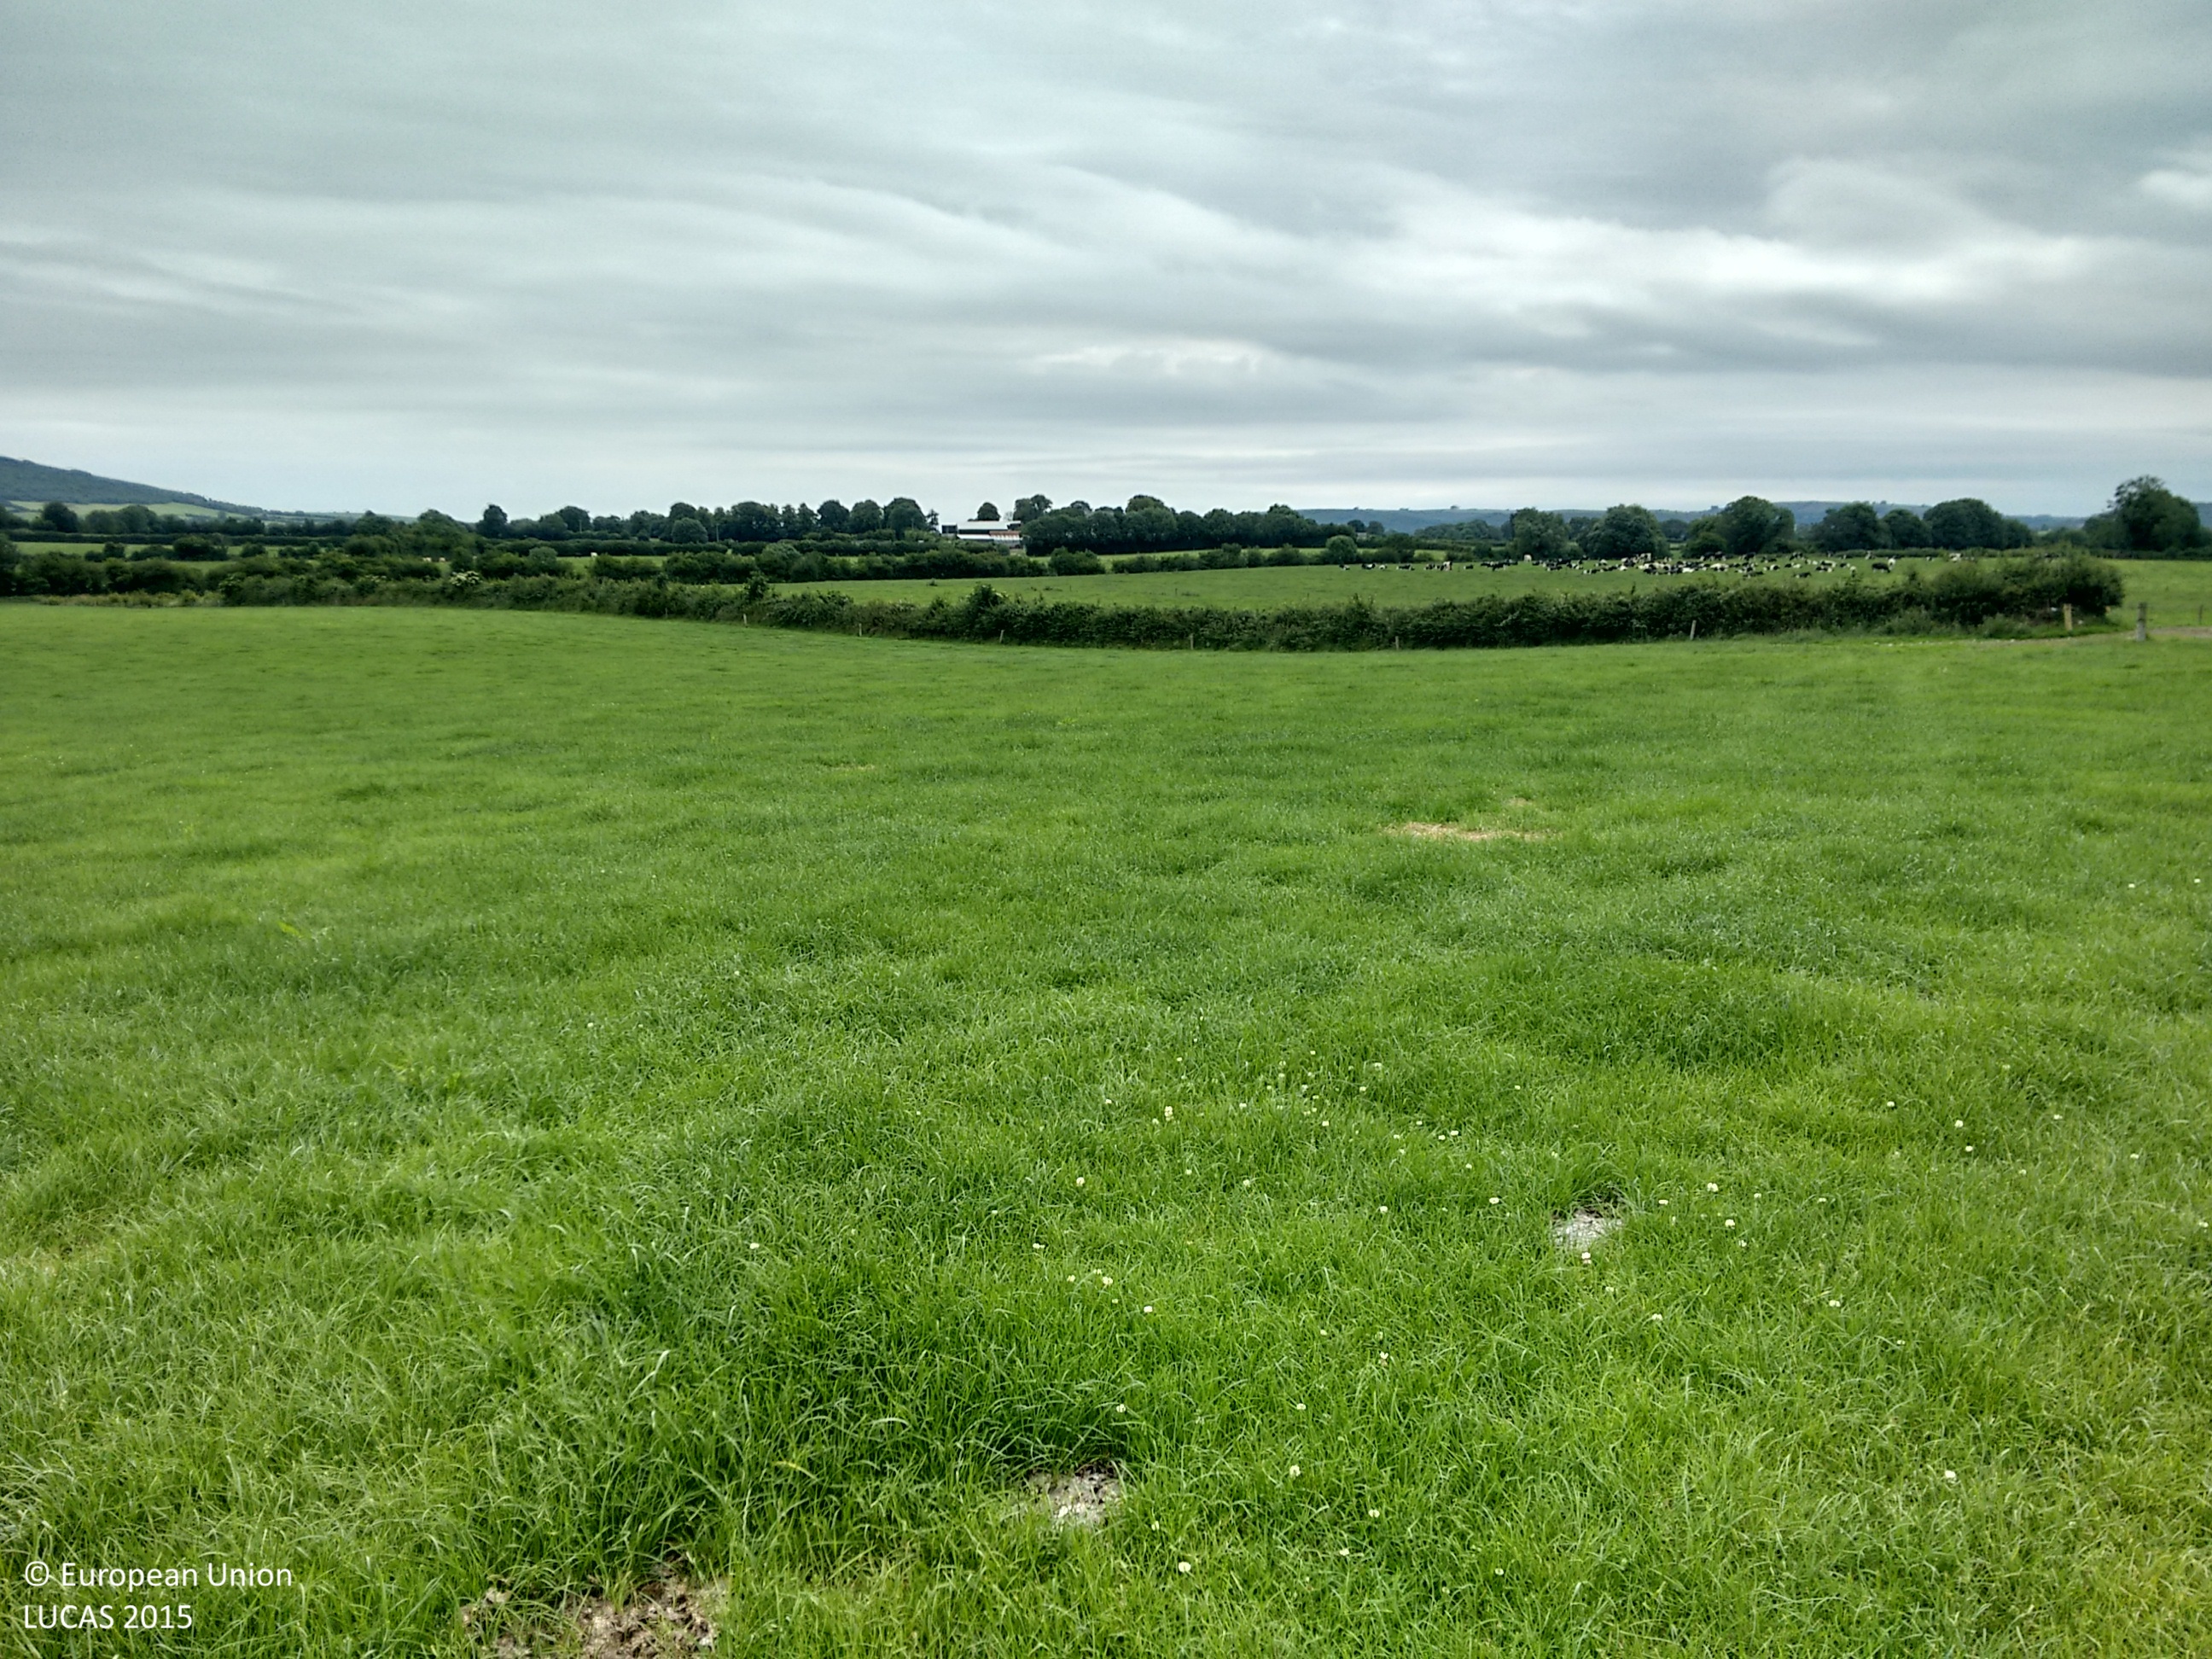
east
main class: Grassland
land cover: Grassland without tree/shrub cover
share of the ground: > 75 %
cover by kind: herbaceous plants 100 %
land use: Agriculture (excluding fallow land and kitchen gardens)
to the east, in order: Grassland without tree/shrub cover; Fences; Abandoned hedges; Fences; Grassland without tree/shrub cover; Fences; Grassland without tree/shrub cover
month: July
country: IE
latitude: 52.7127
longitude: -7.5535
